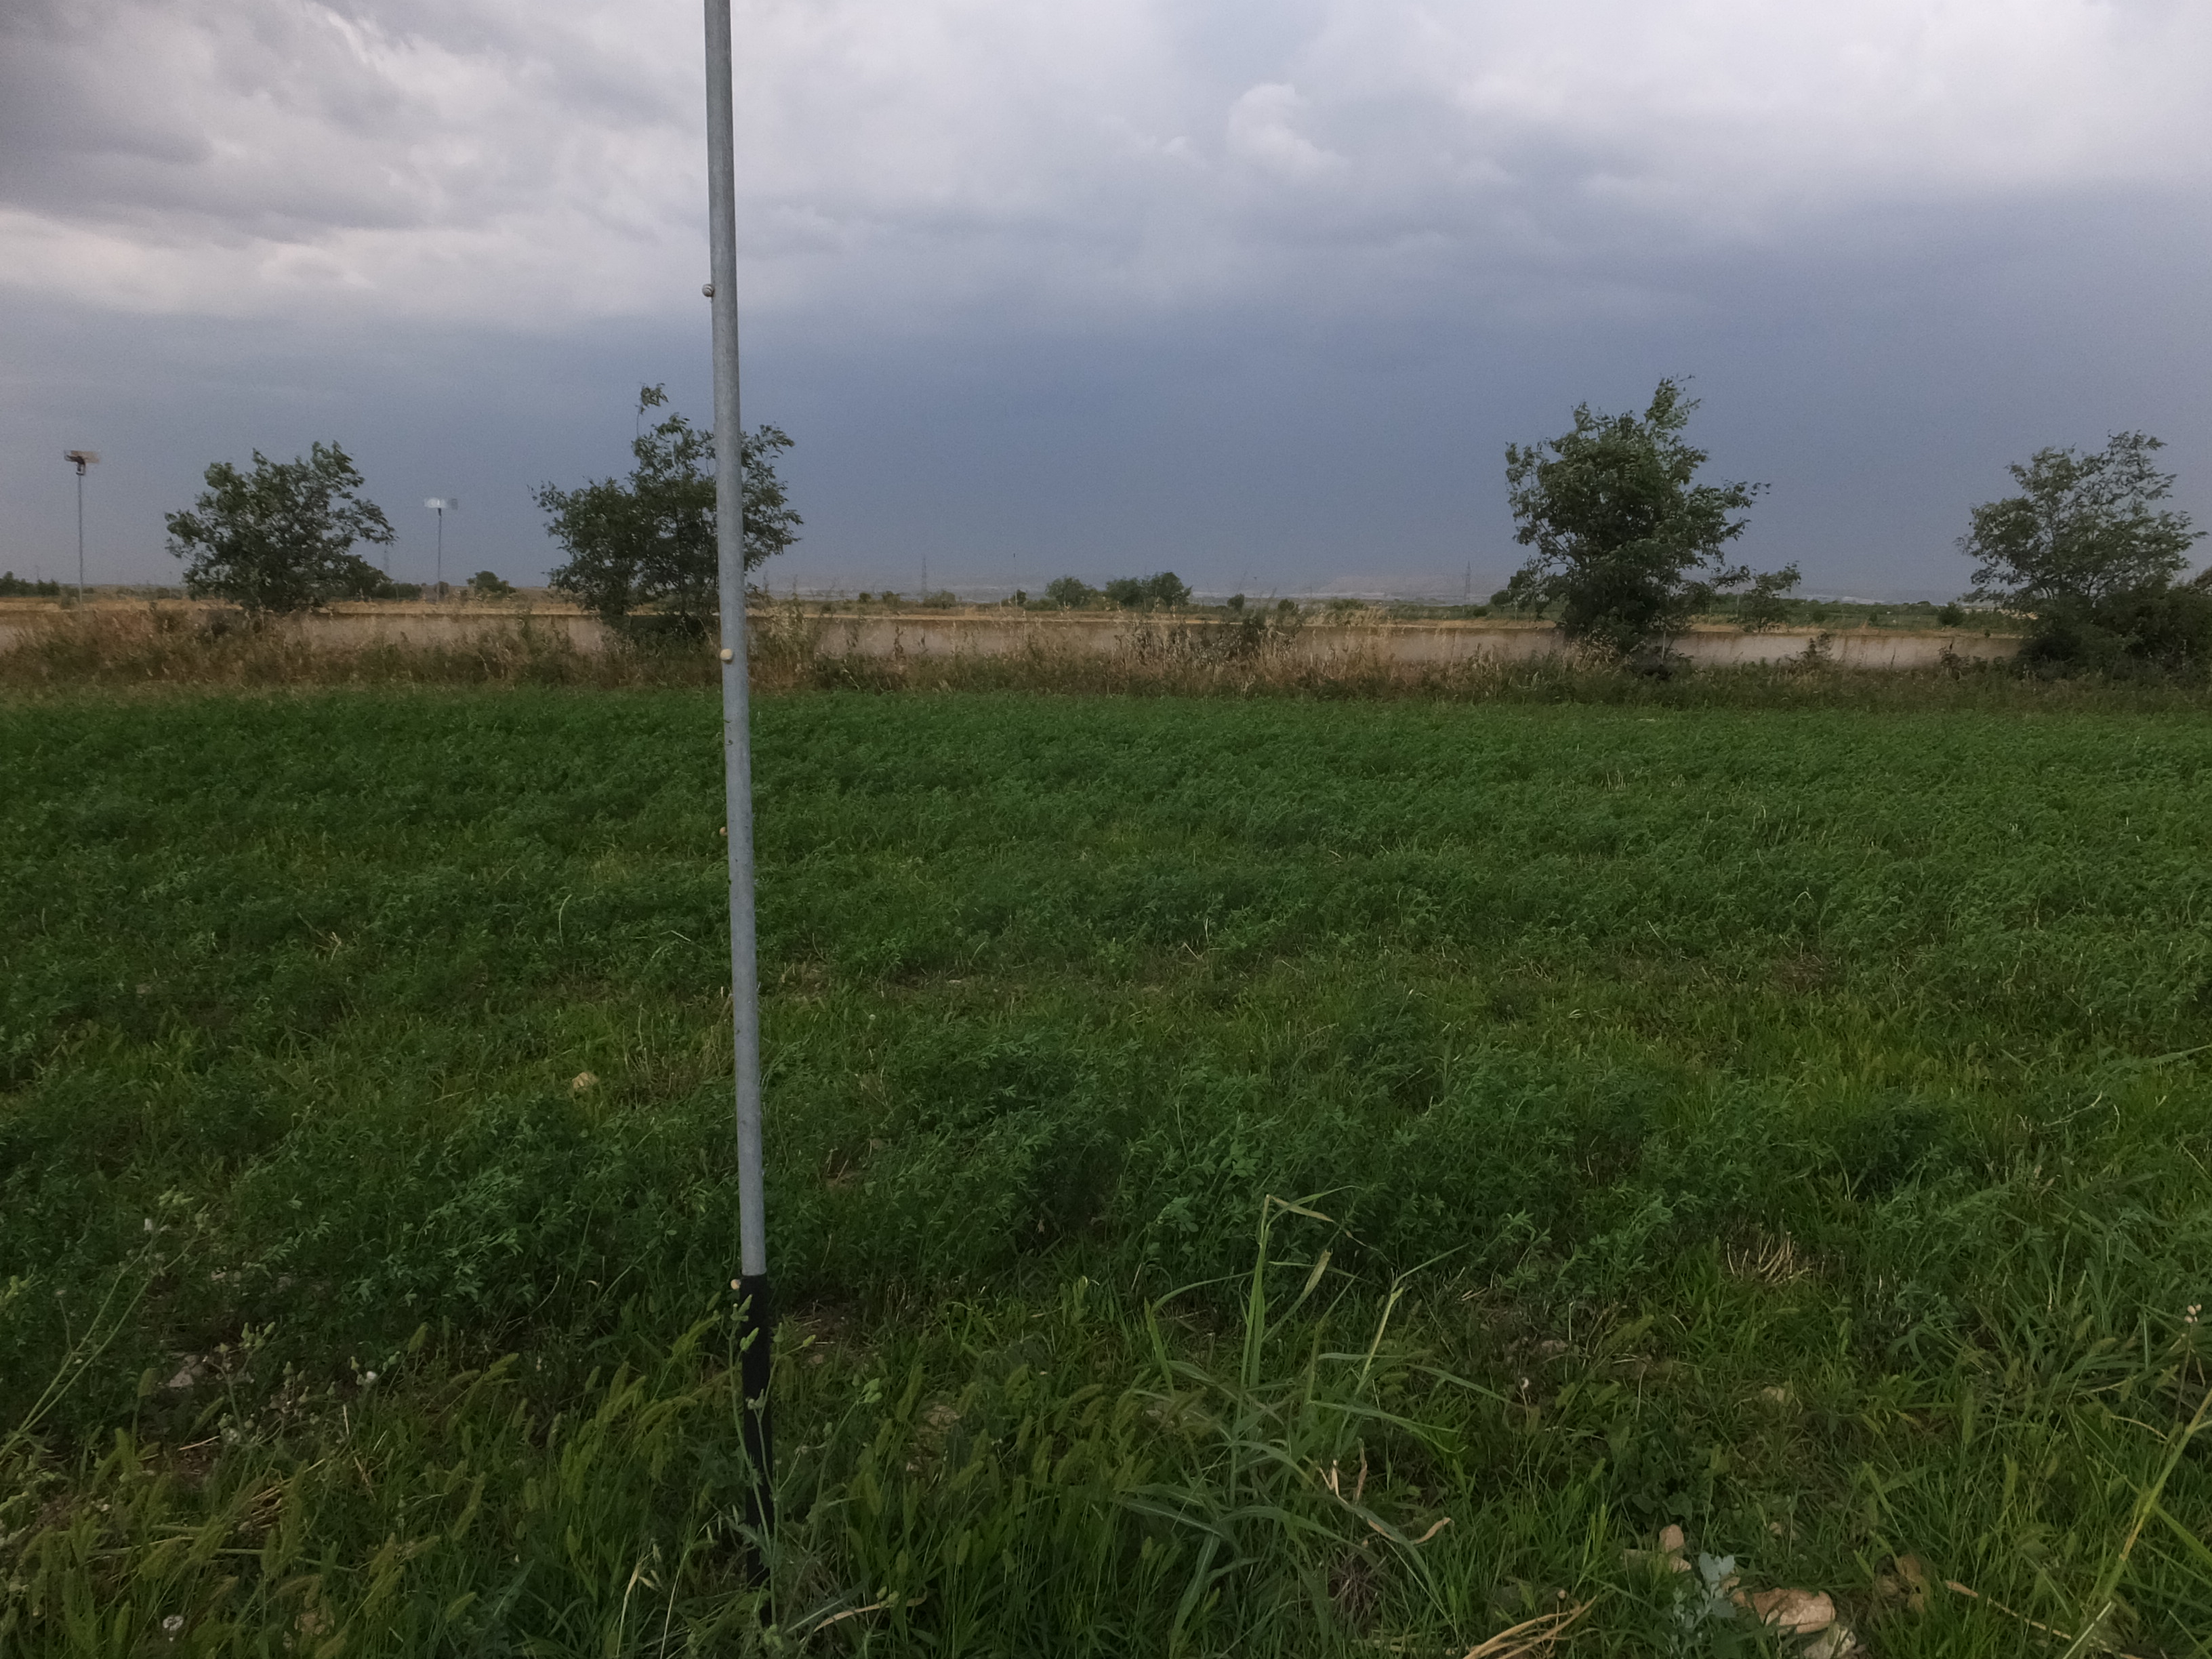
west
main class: Cropland
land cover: Lucerne
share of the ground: > 75 %
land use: Agriculture (excluding fallow land and kitchen gardens)
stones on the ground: < 10 %
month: June
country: ES
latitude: 41.8246
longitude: 0.1228
